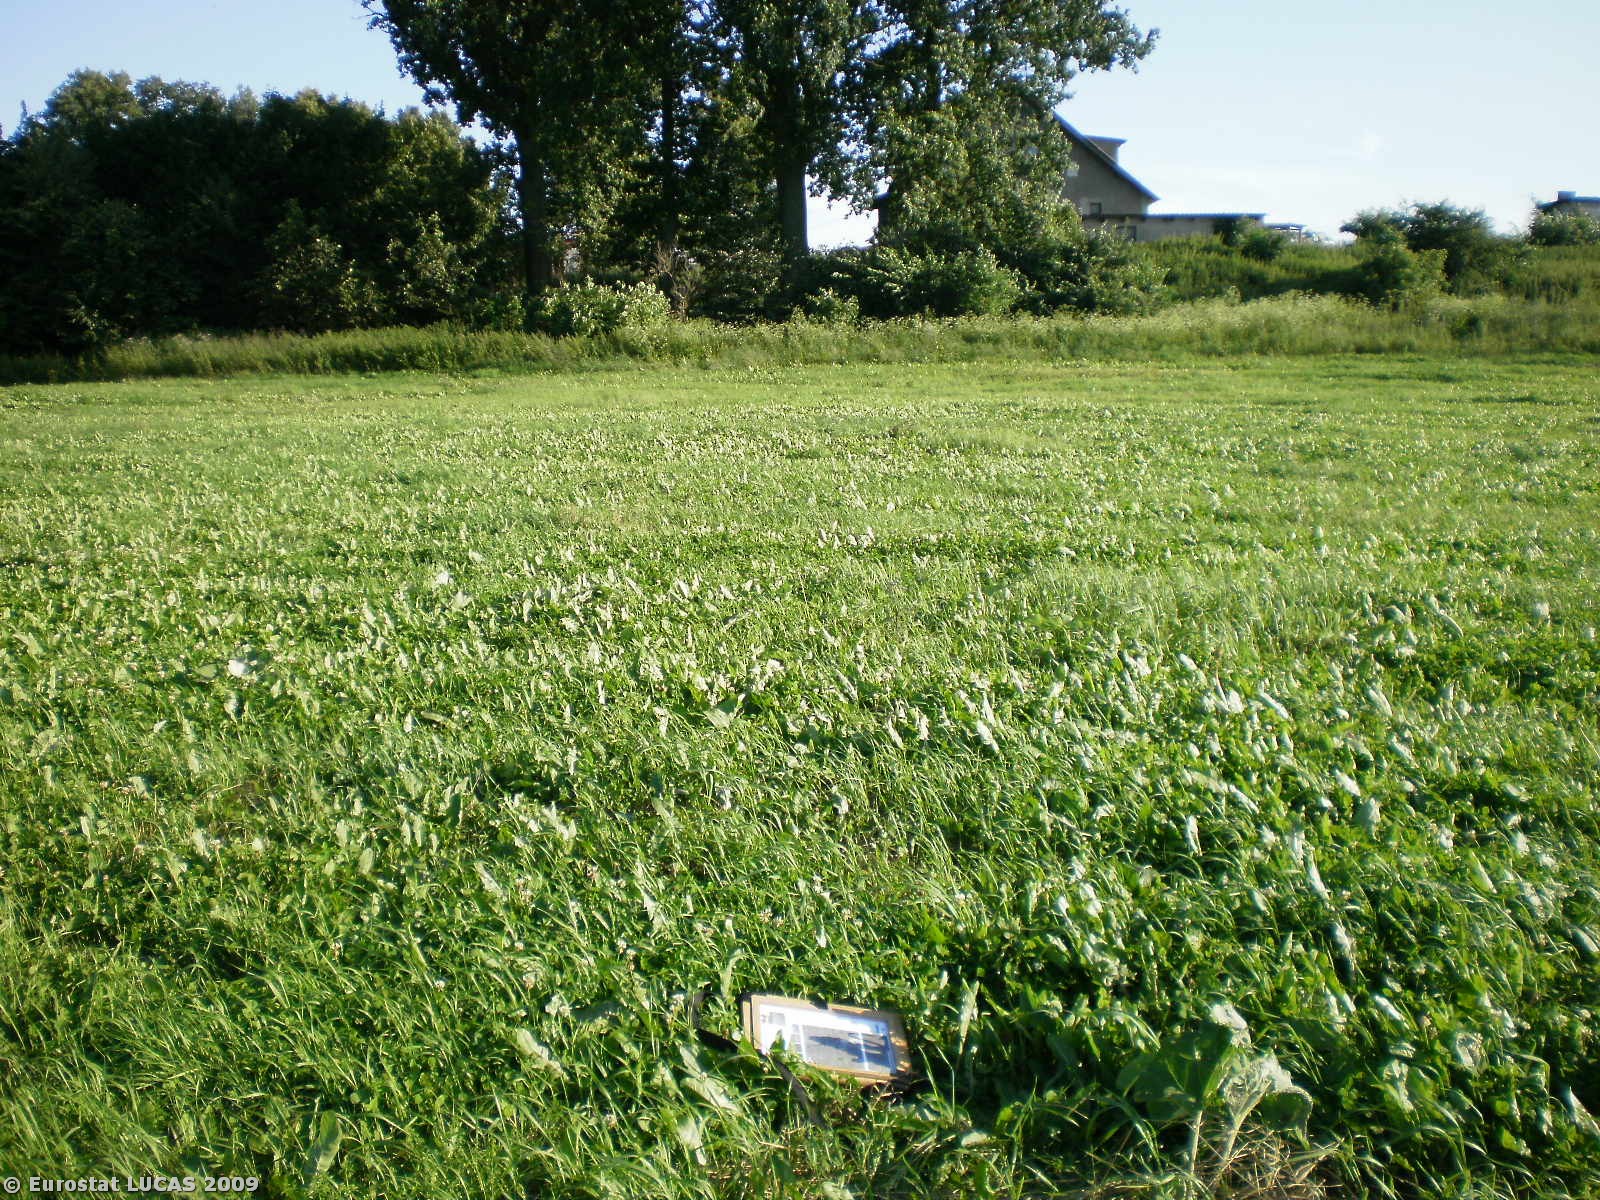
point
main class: Grassland
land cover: Grassland without tree/shrub cover
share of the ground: > 75 %
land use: Agriculture (excluding fallow land and kitchen gardens)
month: July
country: PL
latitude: 53.7686
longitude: 20.6128
